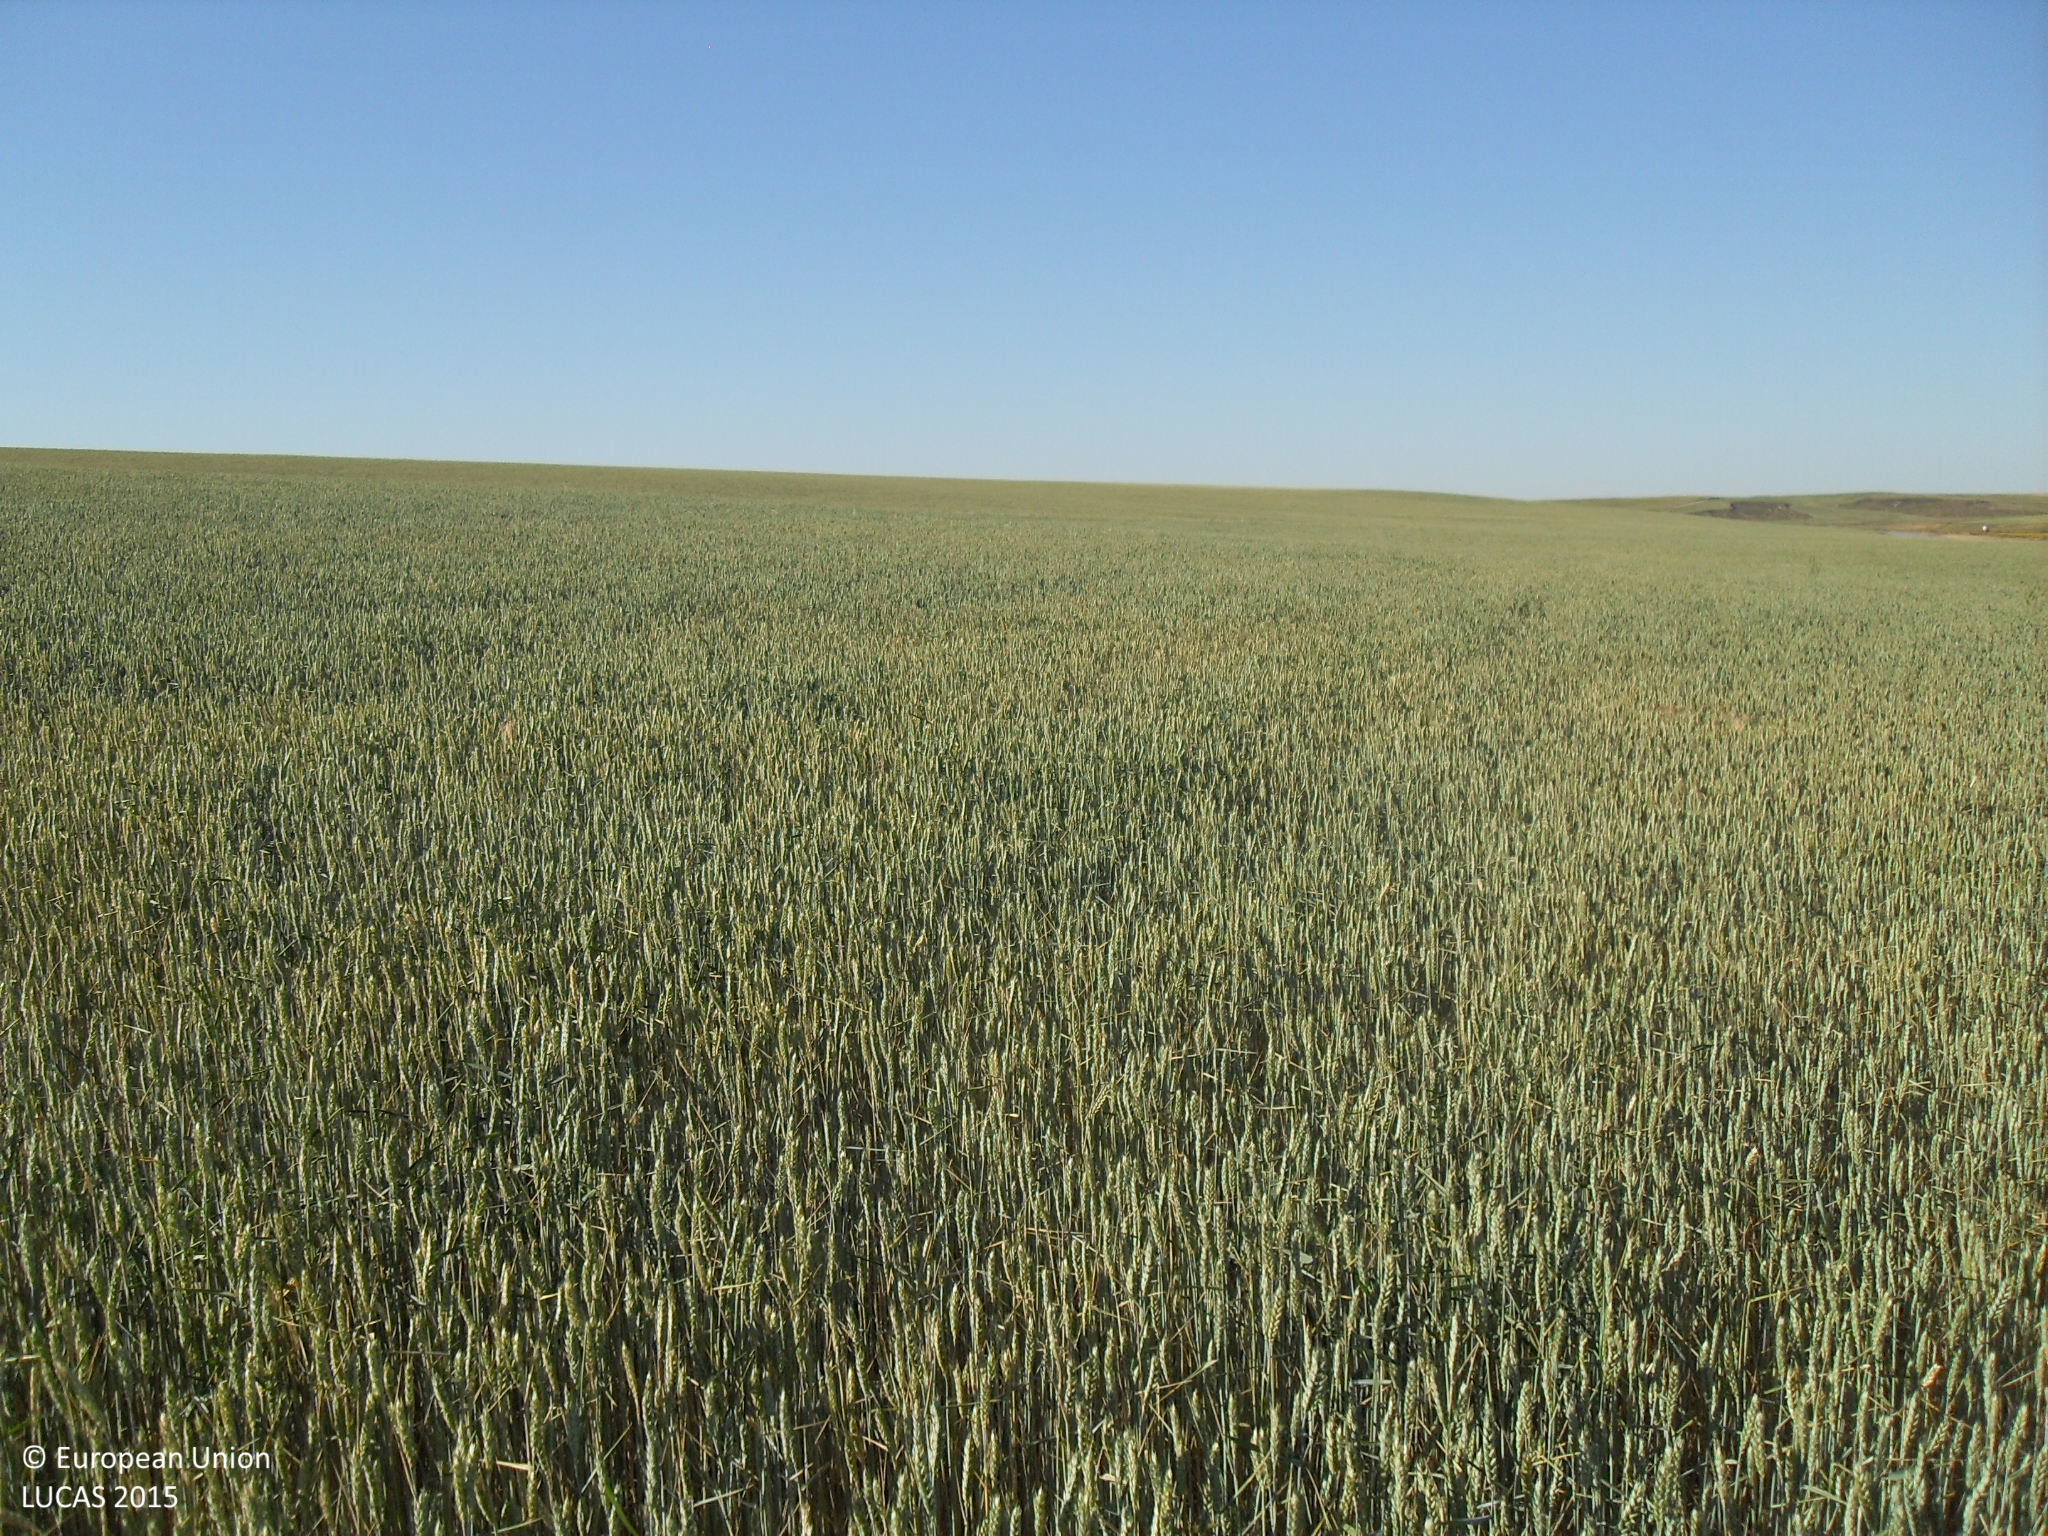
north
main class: Cropland
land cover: Common wheat
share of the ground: > 75 %
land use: Agriculture (excluding fallow land and kitchen gardens)
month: May
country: ES
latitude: 41.0452
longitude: -5.2869
